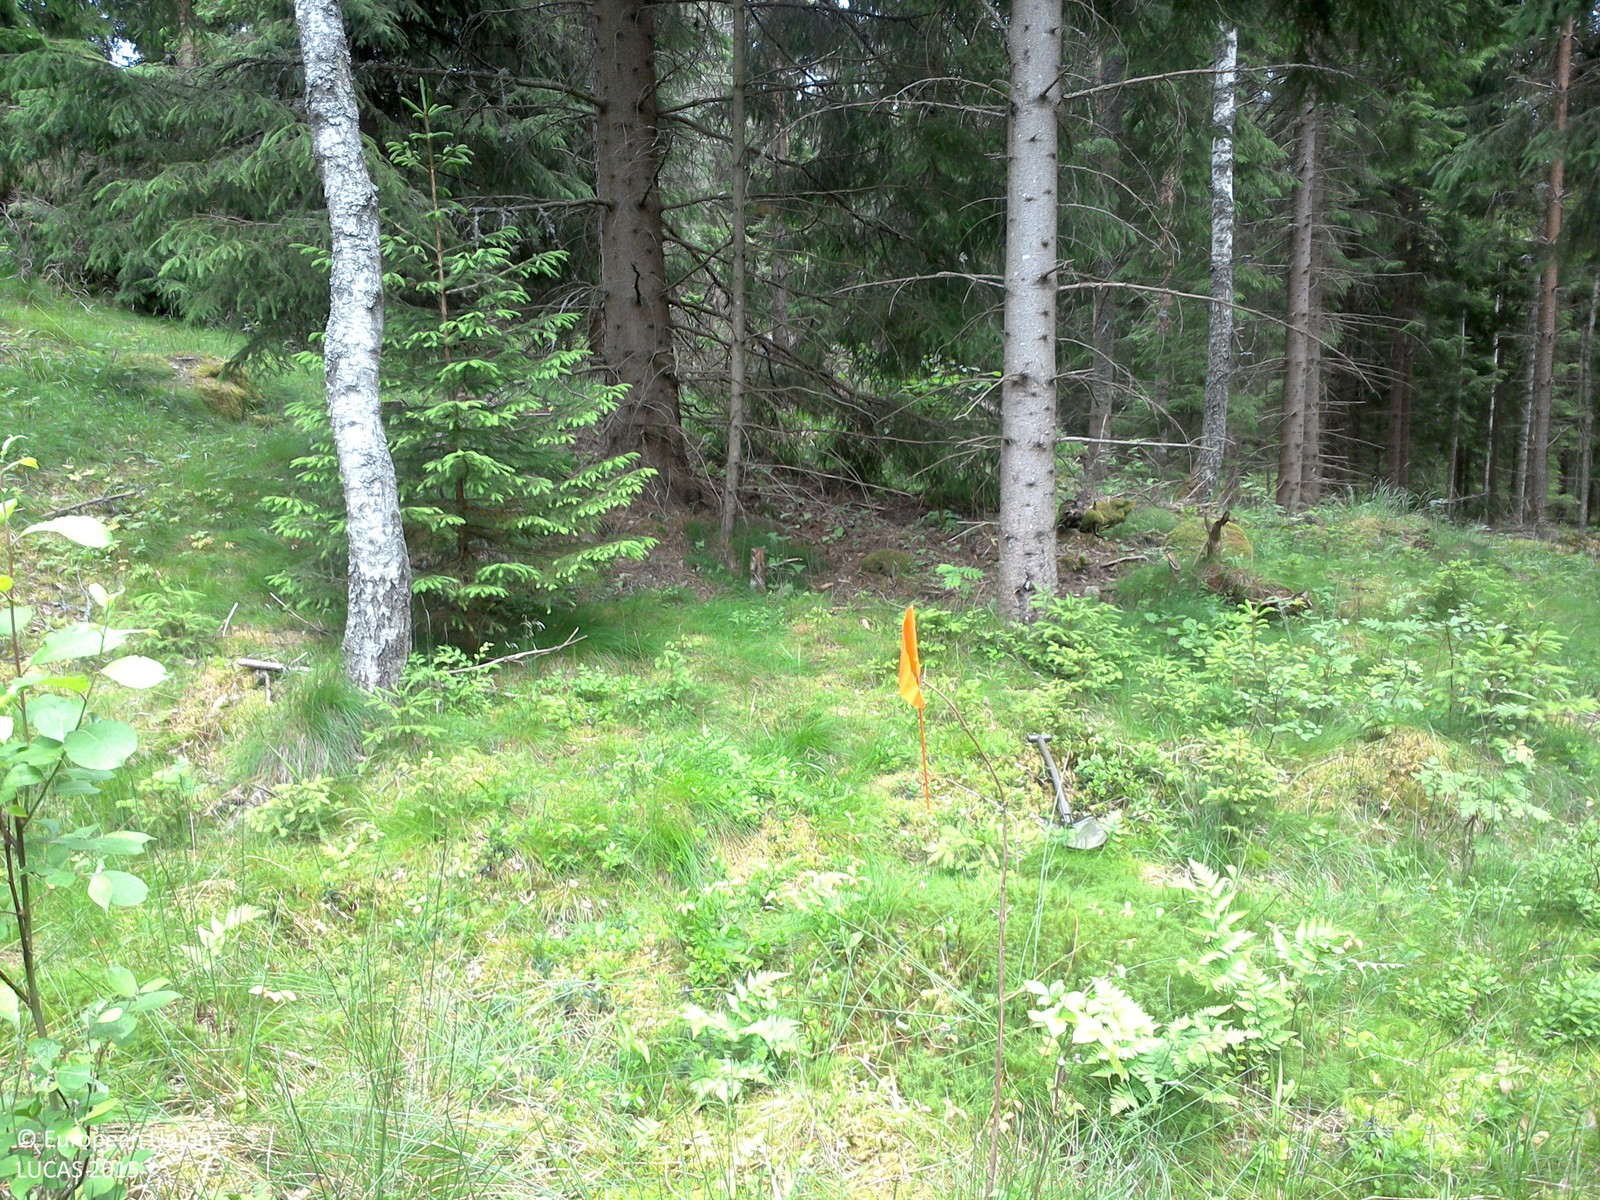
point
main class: Woodland
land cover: Spruce dominated coniferous woodland
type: boreal forest
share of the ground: 50 - 75 %
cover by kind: coniferous forest trees 65 %, herbaceous plants 20 %, lichens and mosses 15 %
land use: Forestry
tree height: > 5 m
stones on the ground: < 10 %
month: June
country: SE
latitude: 57.9548
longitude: 15.6906
